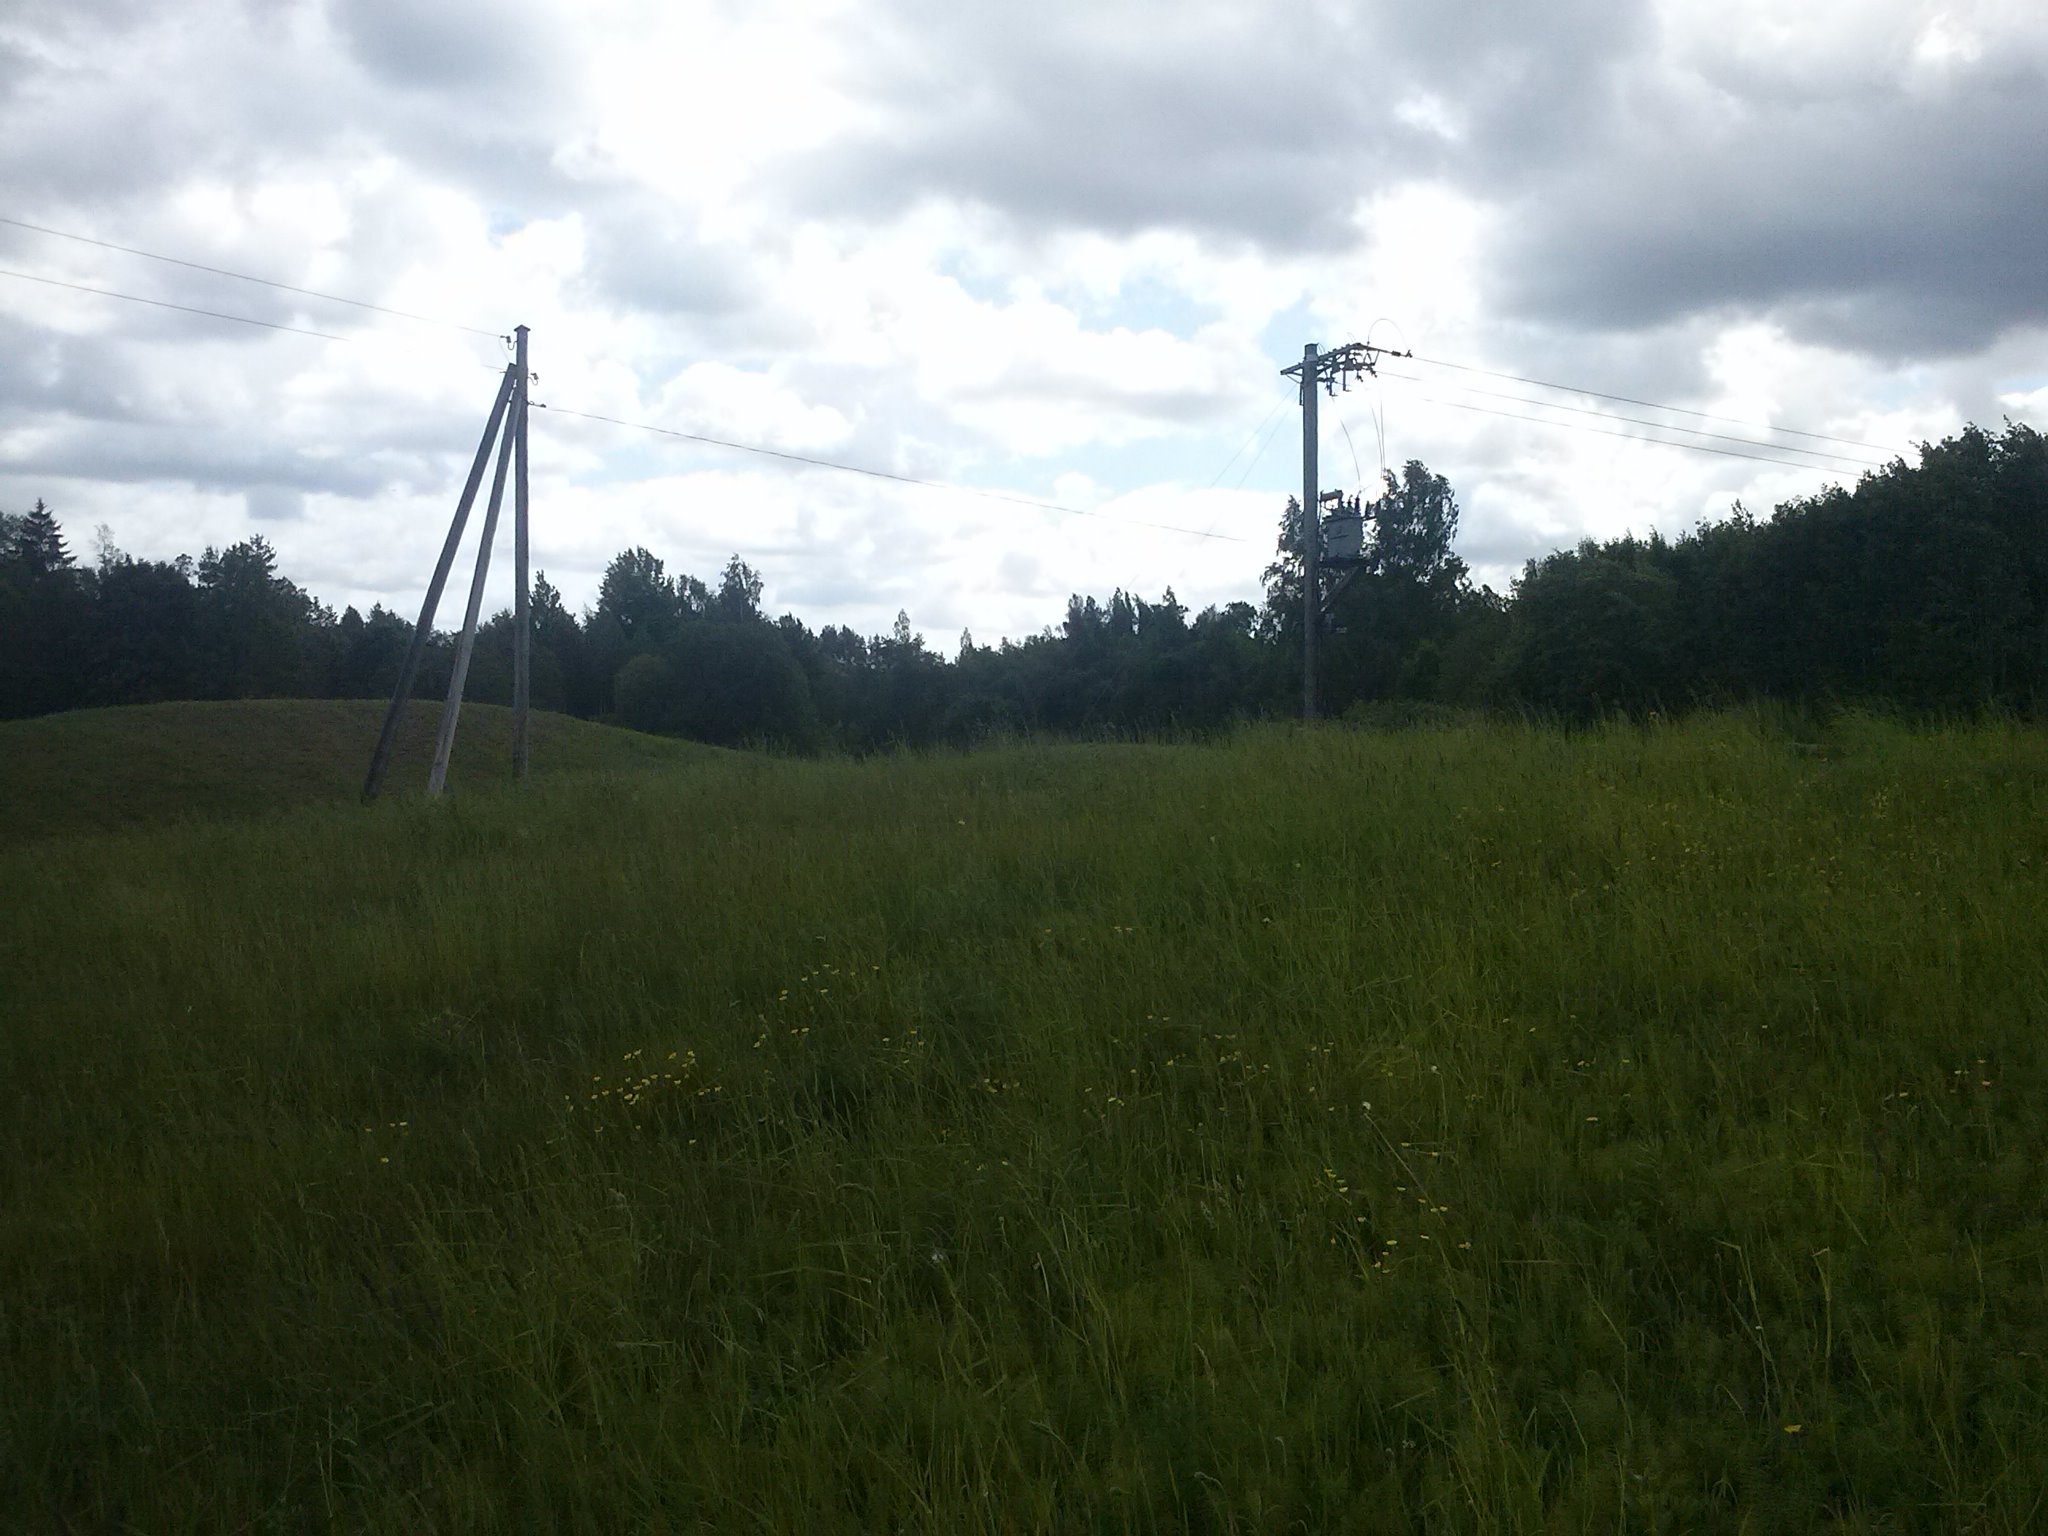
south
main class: Grassland
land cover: Grassland without tree/shrub cover
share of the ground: > 75 %
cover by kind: herbaceous plants 100 %
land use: Agriculture (excluding fallow land and kitchen gardens)
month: June
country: LV
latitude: 56.2663
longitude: 27.6055
